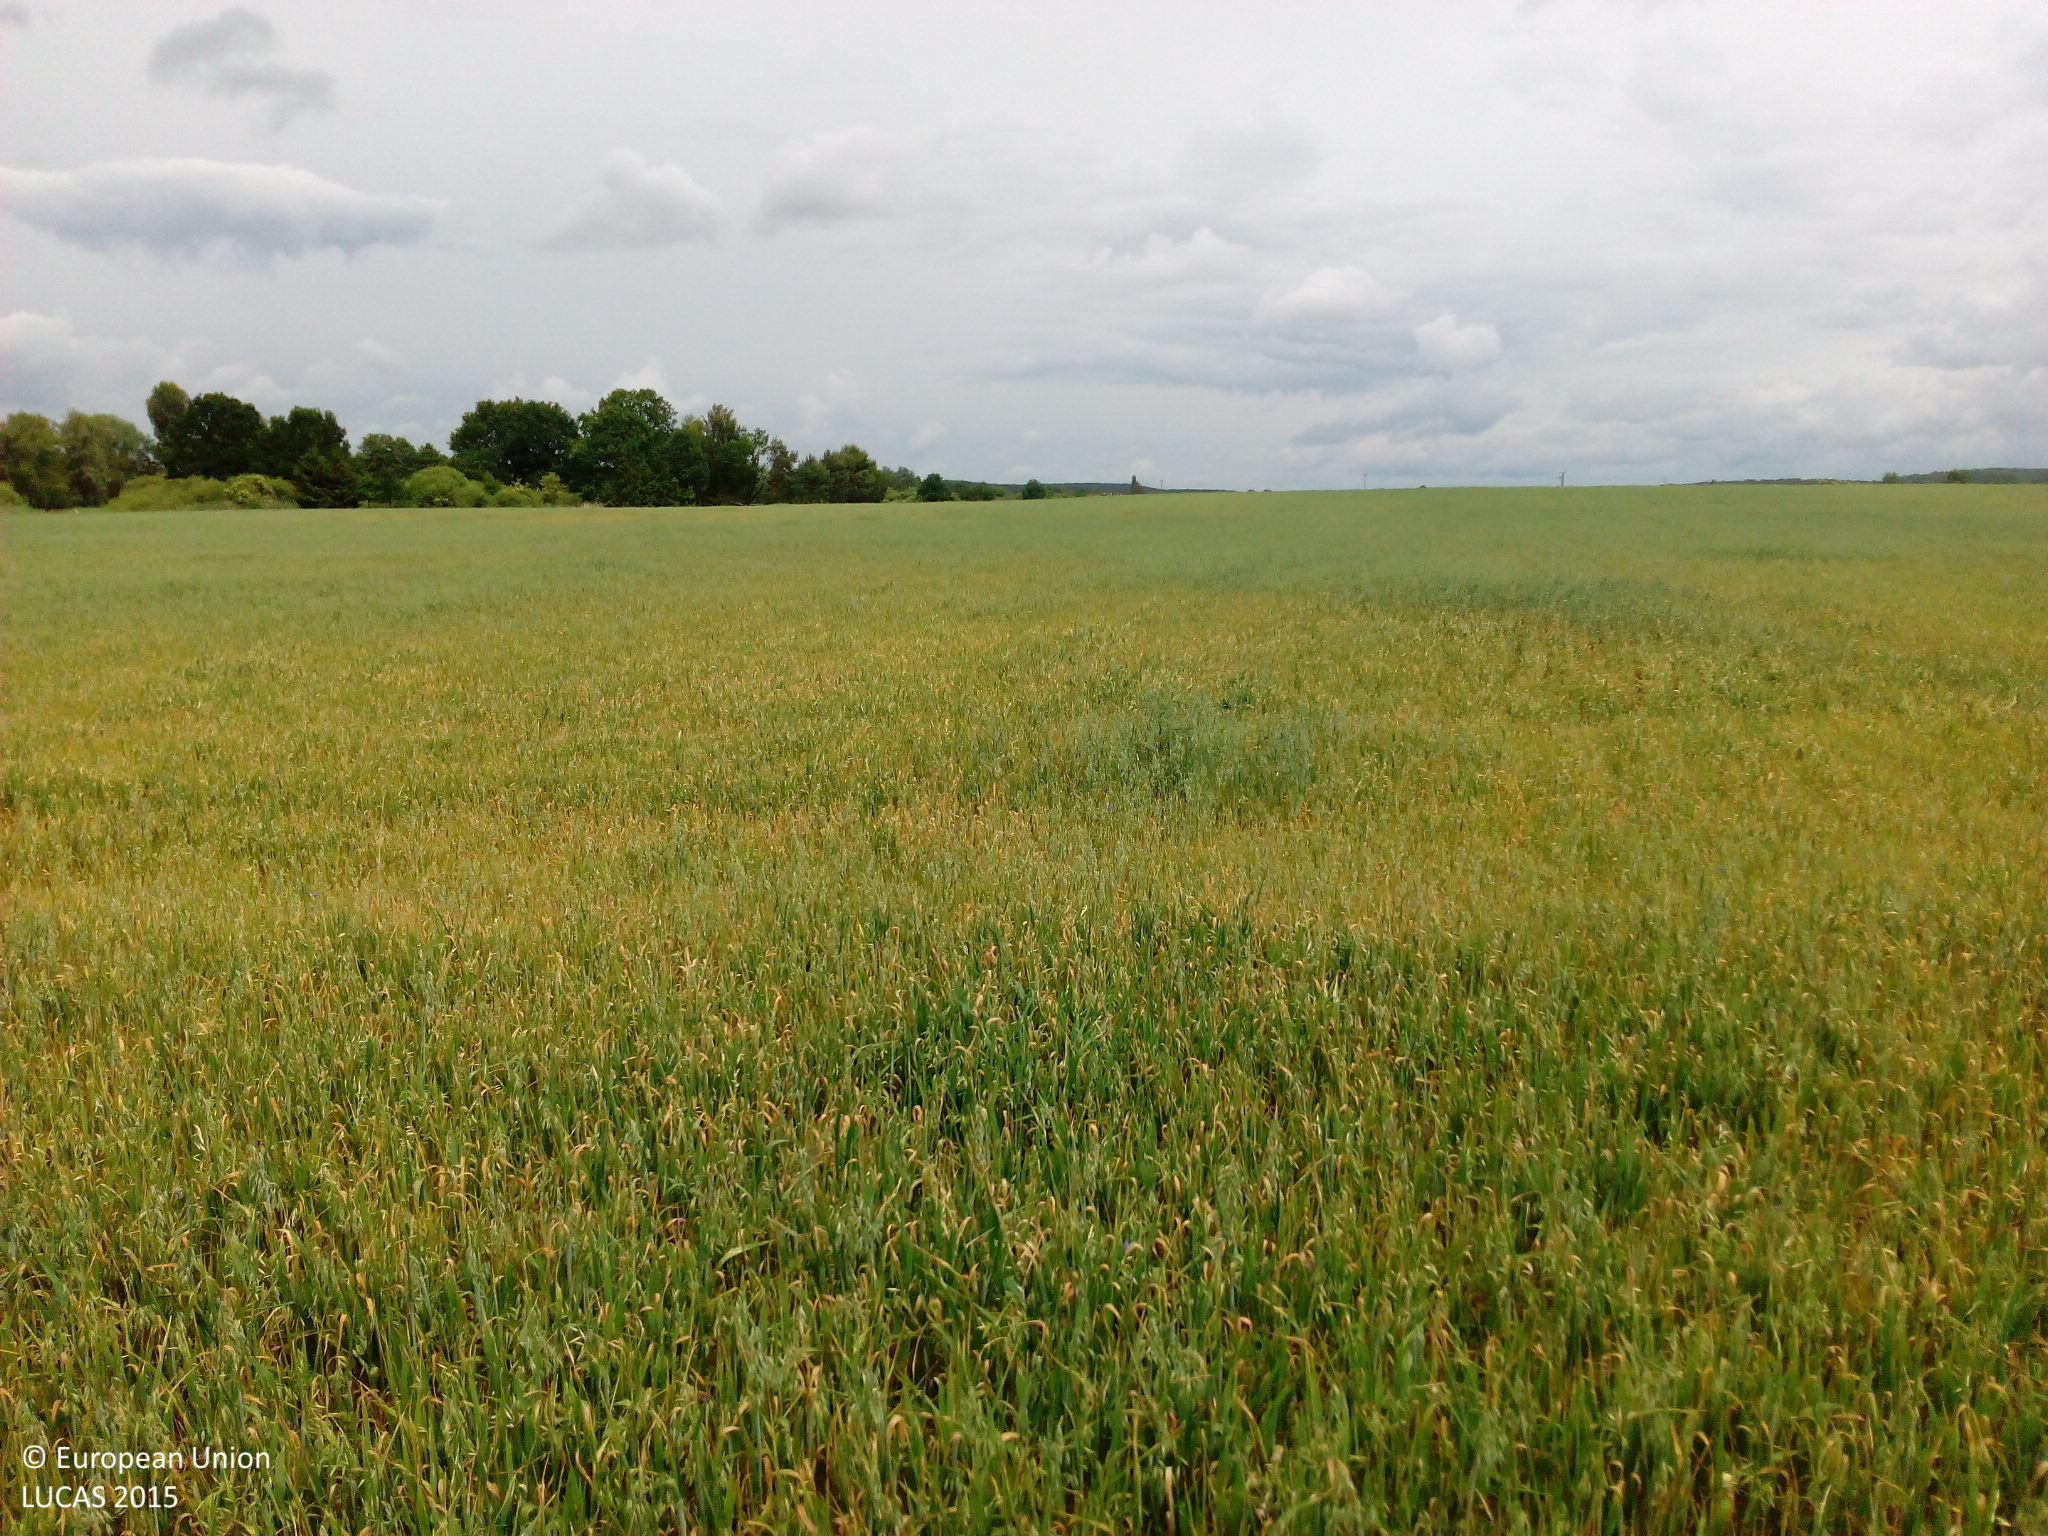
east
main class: Cropland
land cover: Oats
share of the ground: > 75 %
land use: Agriculture (excluding fallow land and kitchen gardens)
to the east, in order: Oats; Paved roads, cycling and walking lanes; Oats
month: June
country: DE
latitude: 52.4779
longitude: 12.4584
